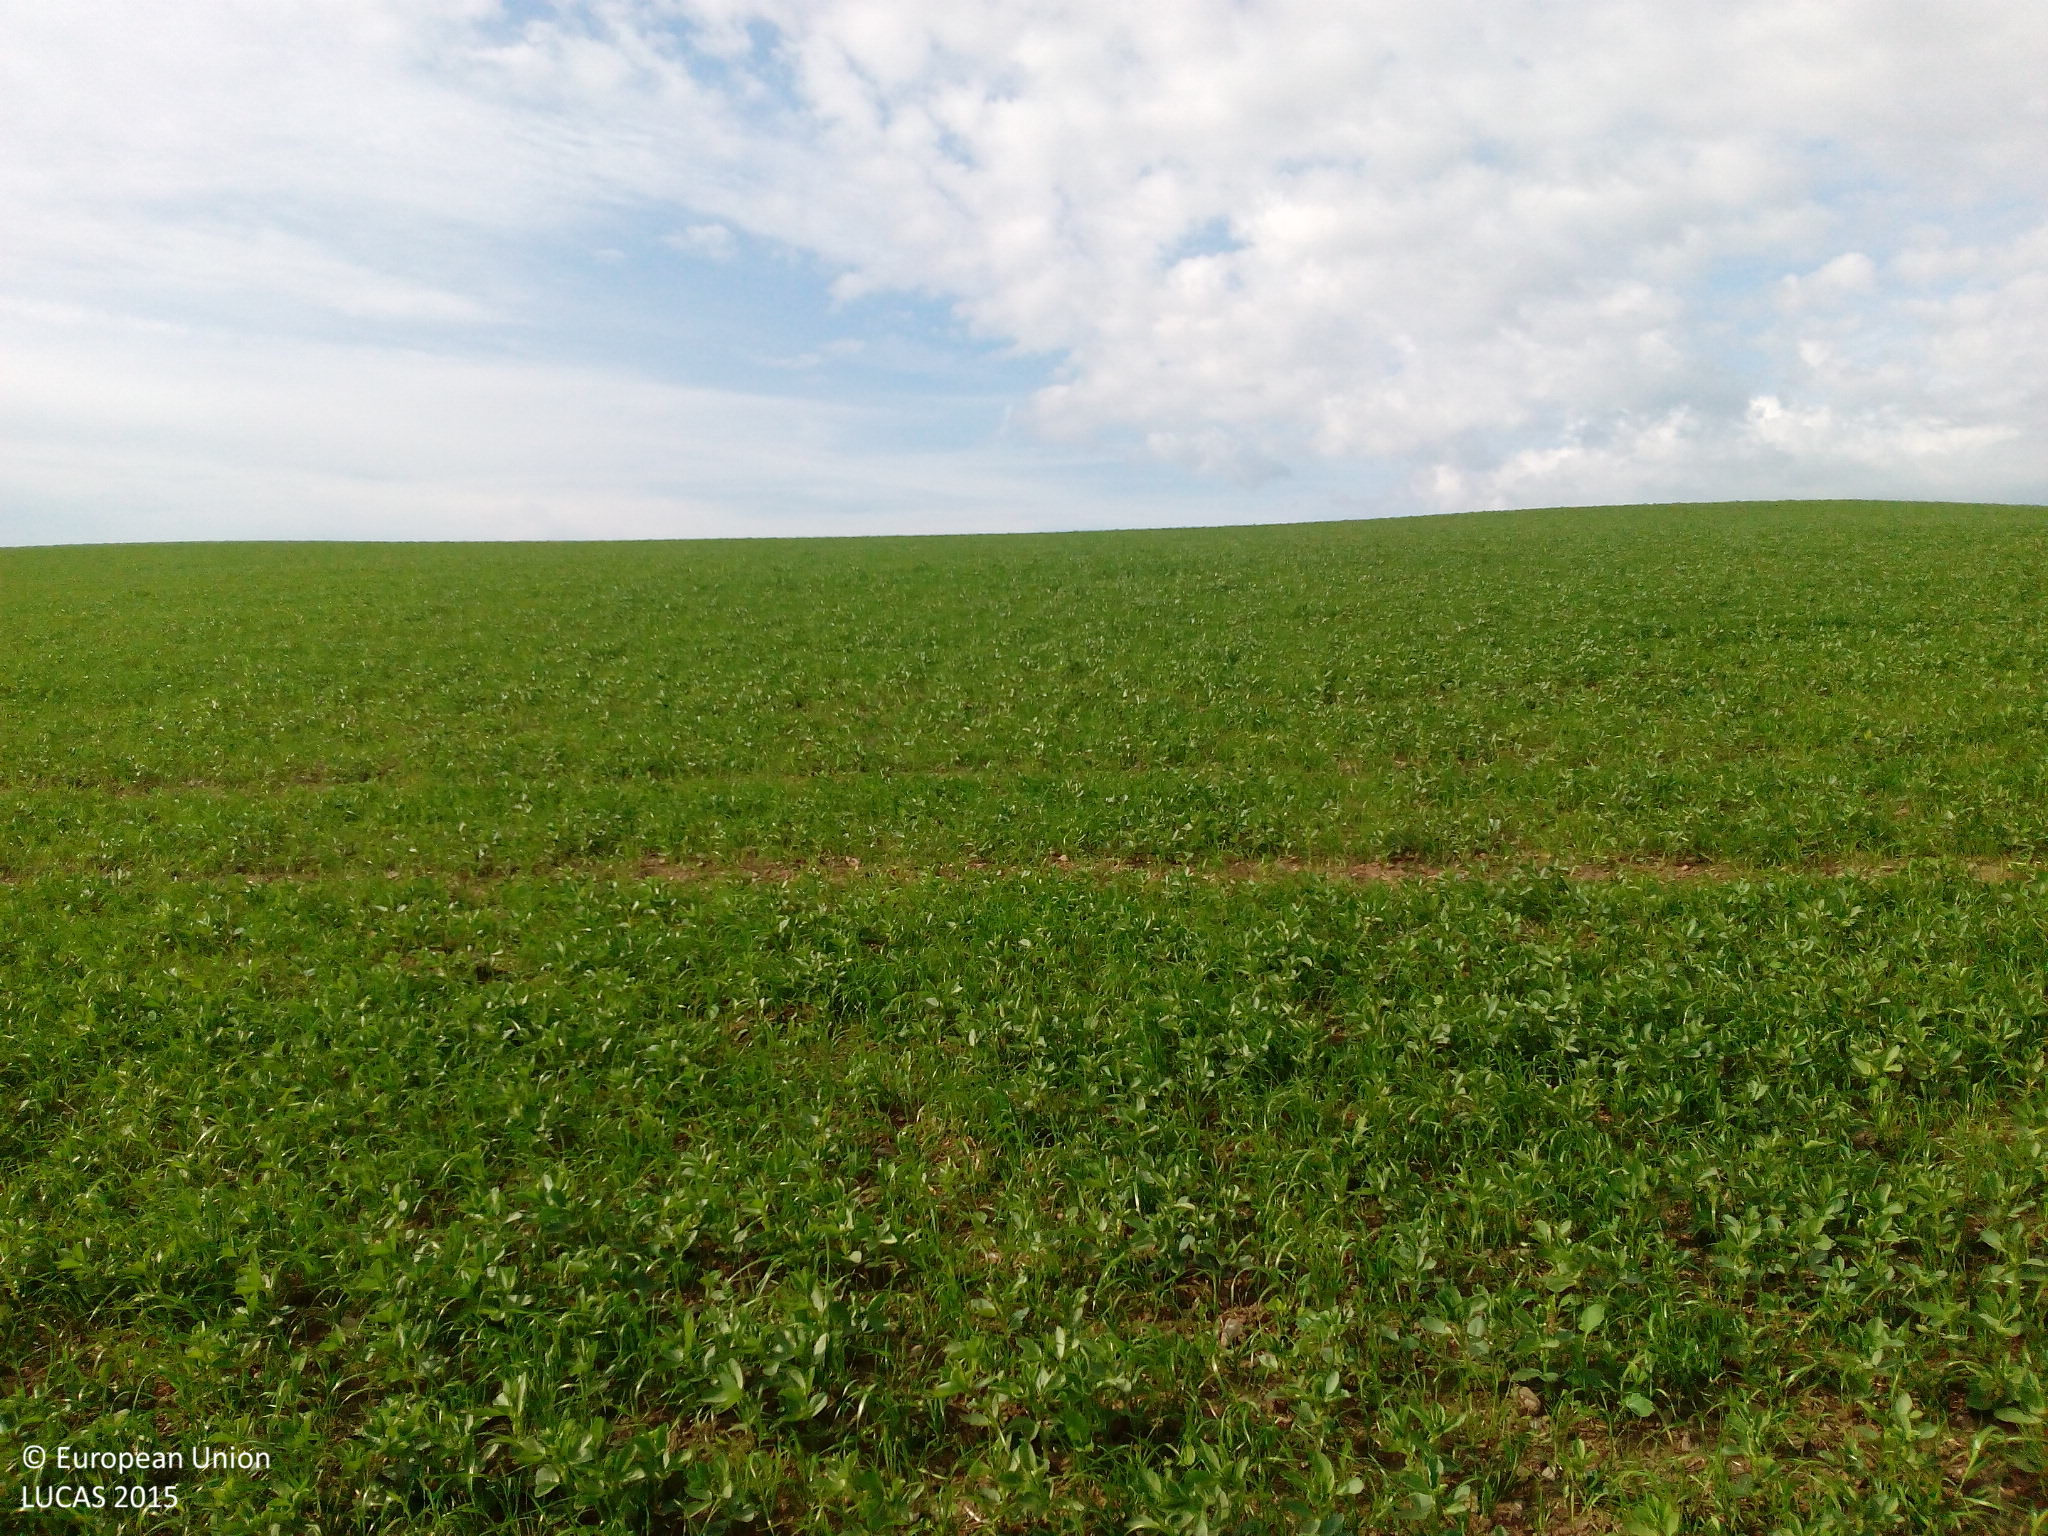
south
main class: Cropland
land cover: Sunflower
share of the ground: 25 - 50 %
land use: Agriculture (excluding fallow land and kitchen gardens)
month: May
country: DE
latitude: 50.8459
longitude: 13.0252
